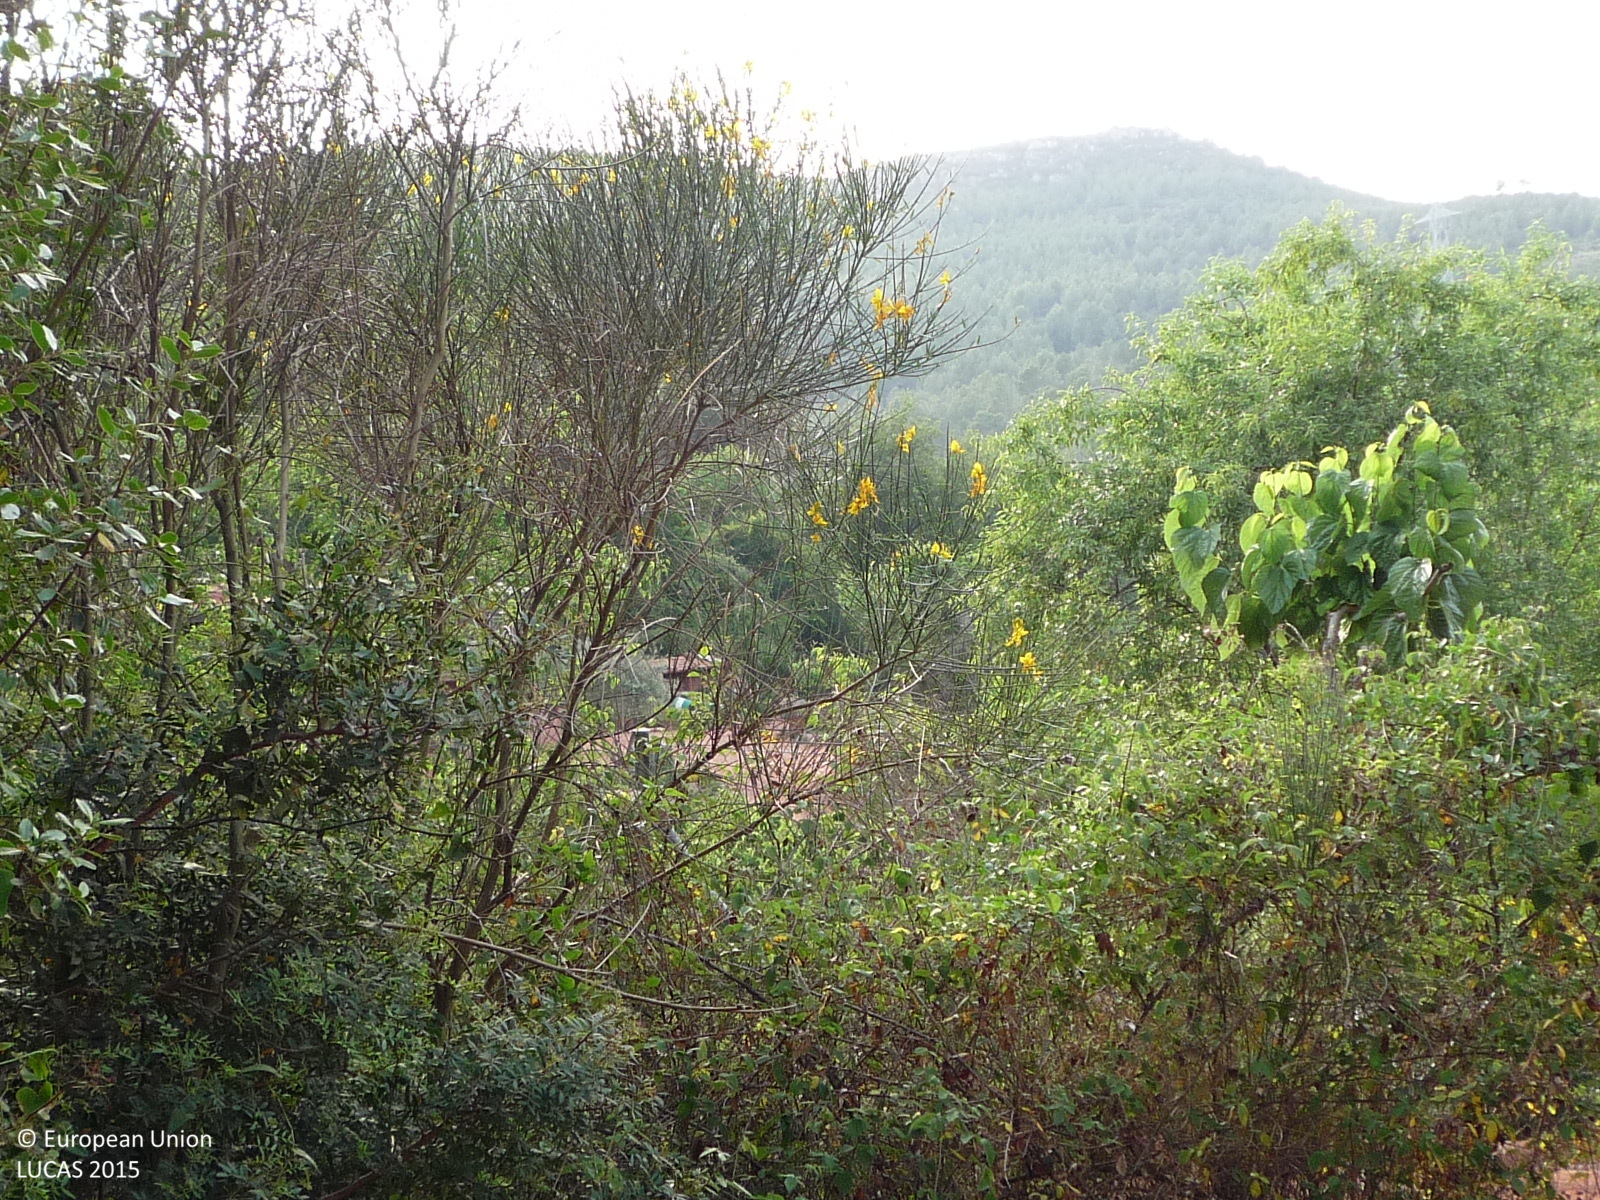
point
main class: Woodland
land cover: Broadleaved woodland
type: broadleaved evergreen forest
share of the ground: > 75 %
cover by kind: broadleaved forest trees 80 %, shrubs 20 %
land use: Semi-natural and natural areas not in use
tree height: > 5 m
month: May
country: ES
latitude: 41.4289
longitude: 1.9880
